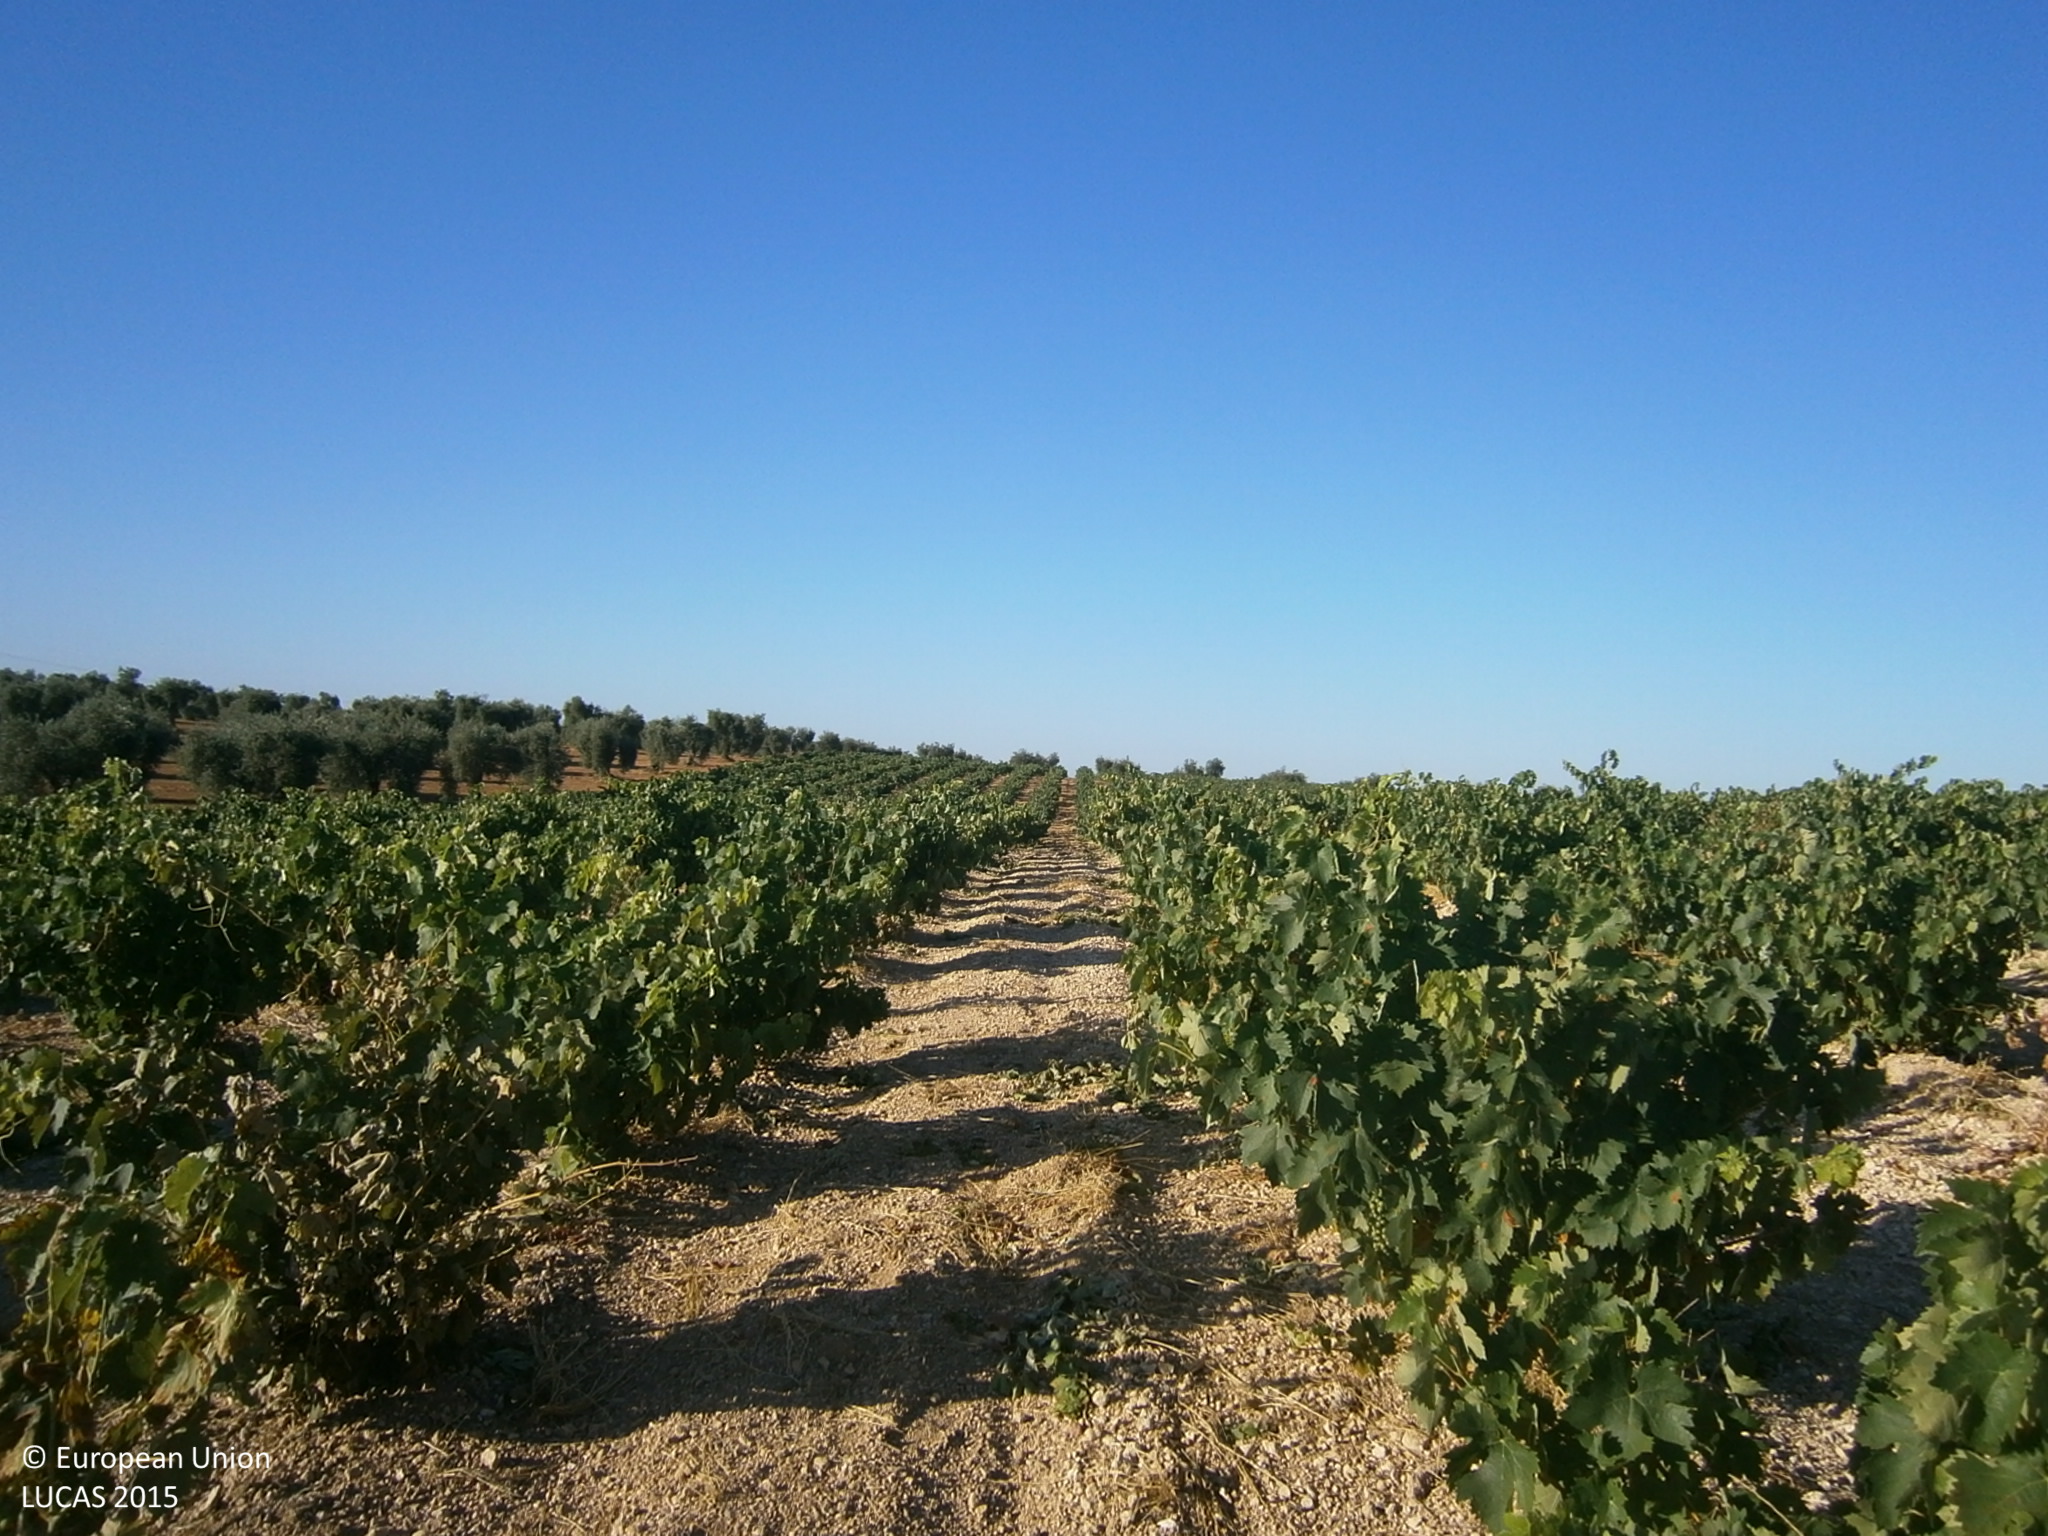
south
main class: Cropland
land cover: Vineyards
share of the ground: 25 - 50 %
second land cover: Other bare soil
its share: > 75 %
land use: Agriculture (excluding fallow land and kitchen gardens)
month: June
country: ES
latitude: 38.8194
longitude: -6.5179
